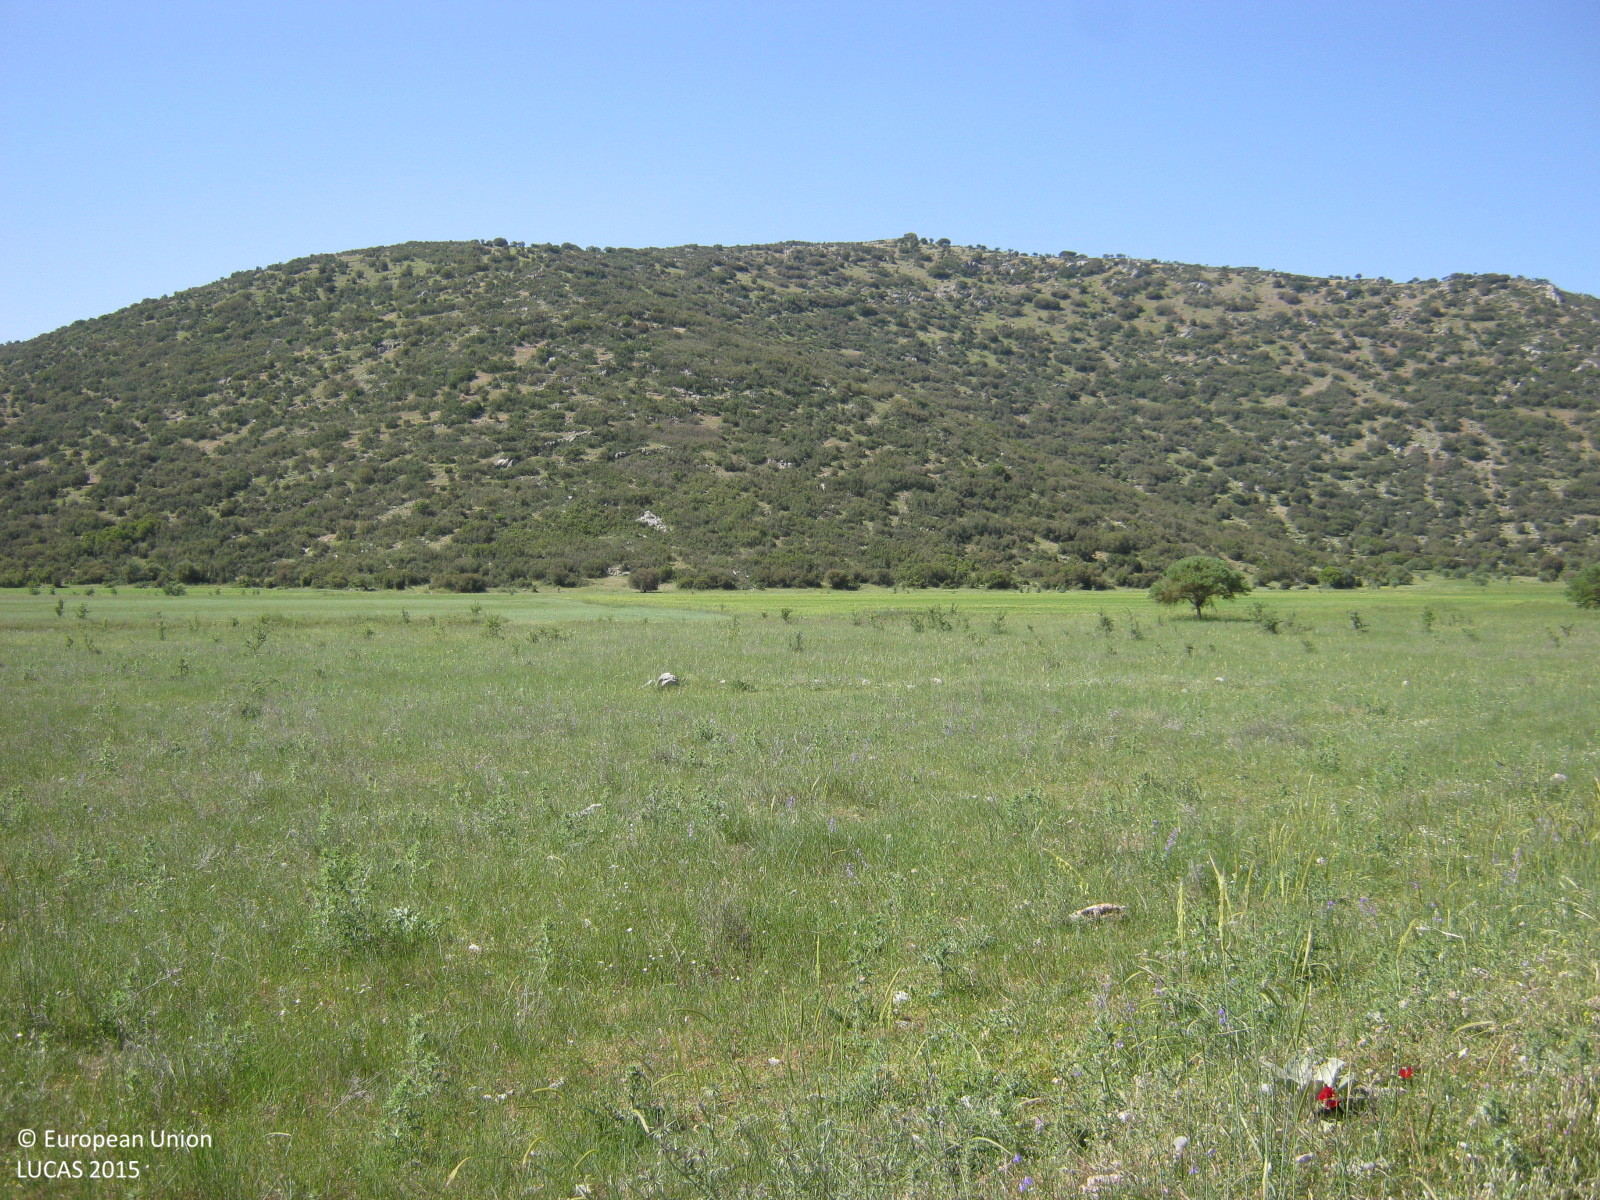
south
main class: Grassland
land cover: Grassland with sparse tree/shrub cover
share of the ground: > 75 %
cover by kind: herbaceous plants 90 %, broadleaved forest trees 5 %, shrubs 5 %
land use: Agriculture (excluding fallow land and kitchen gardens)
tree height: < 5 m
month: May
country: GR
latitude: 37.6892
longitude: 22.3591
